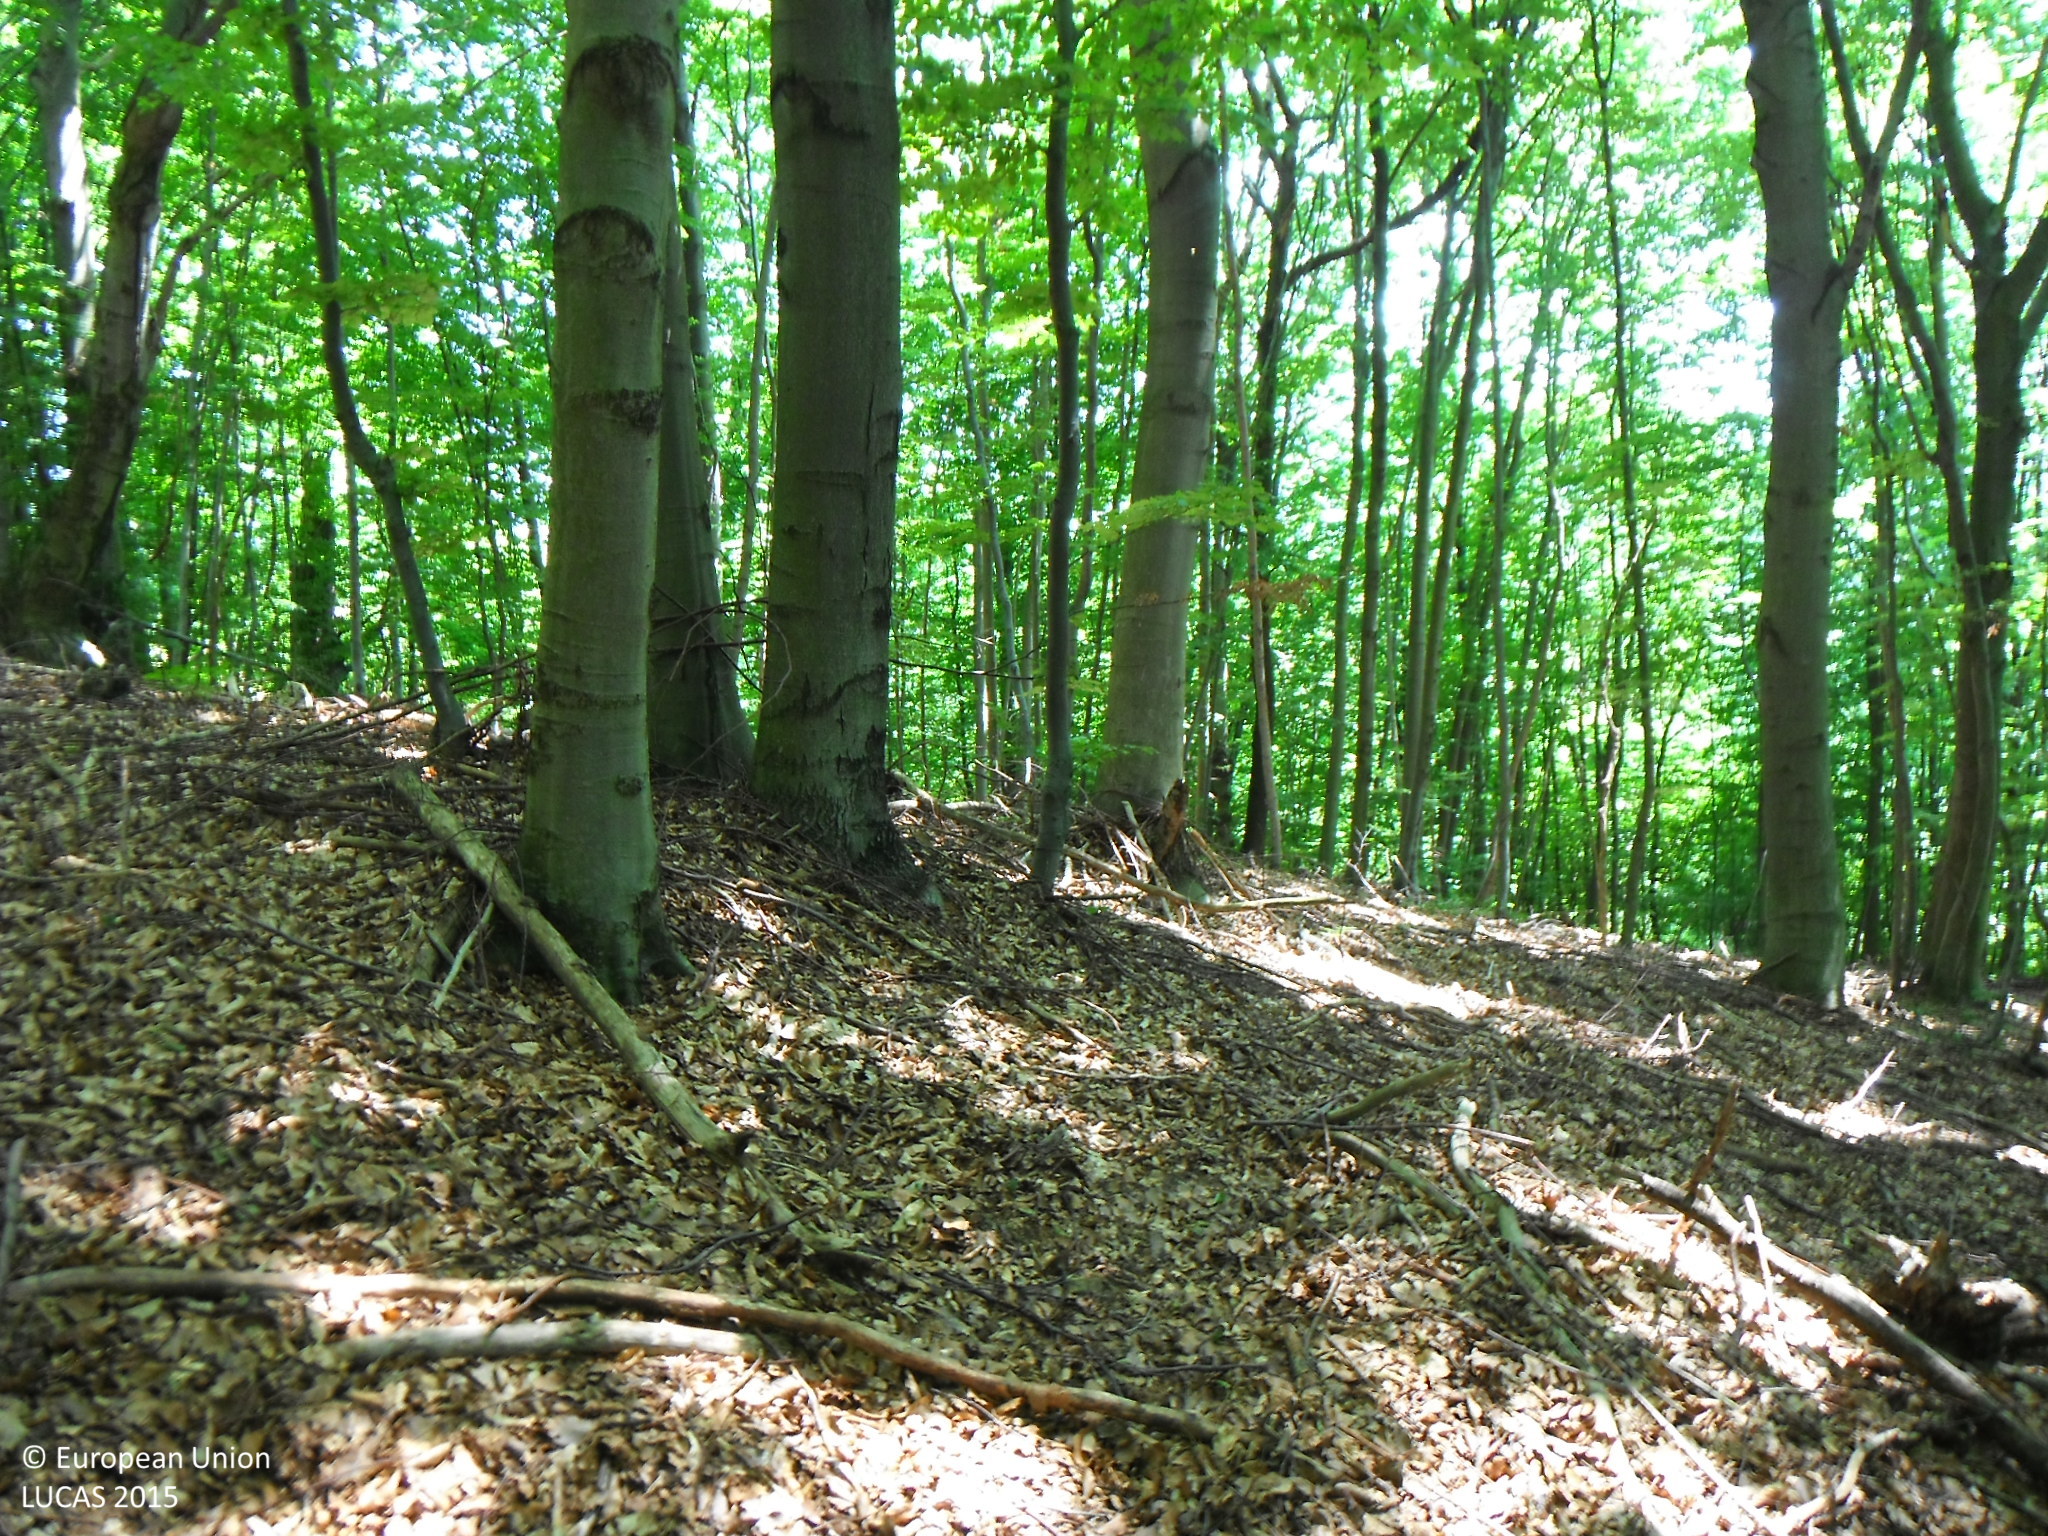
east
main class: Woodland
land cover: Broadleaved woodland
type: beech forest
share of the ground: > 75 %
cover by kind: broadleaved forest trees 100 %
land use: Forestry
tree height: > 5 m
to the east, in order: Broadleaved woodland; Spontaneously vegetated surfaces; Broadleaved woodland; Grassland without tree/shrub cover; Tracks; Grassland without tree/shrub cover
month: July
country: SK
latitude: 49.3775
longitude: 21.1878
